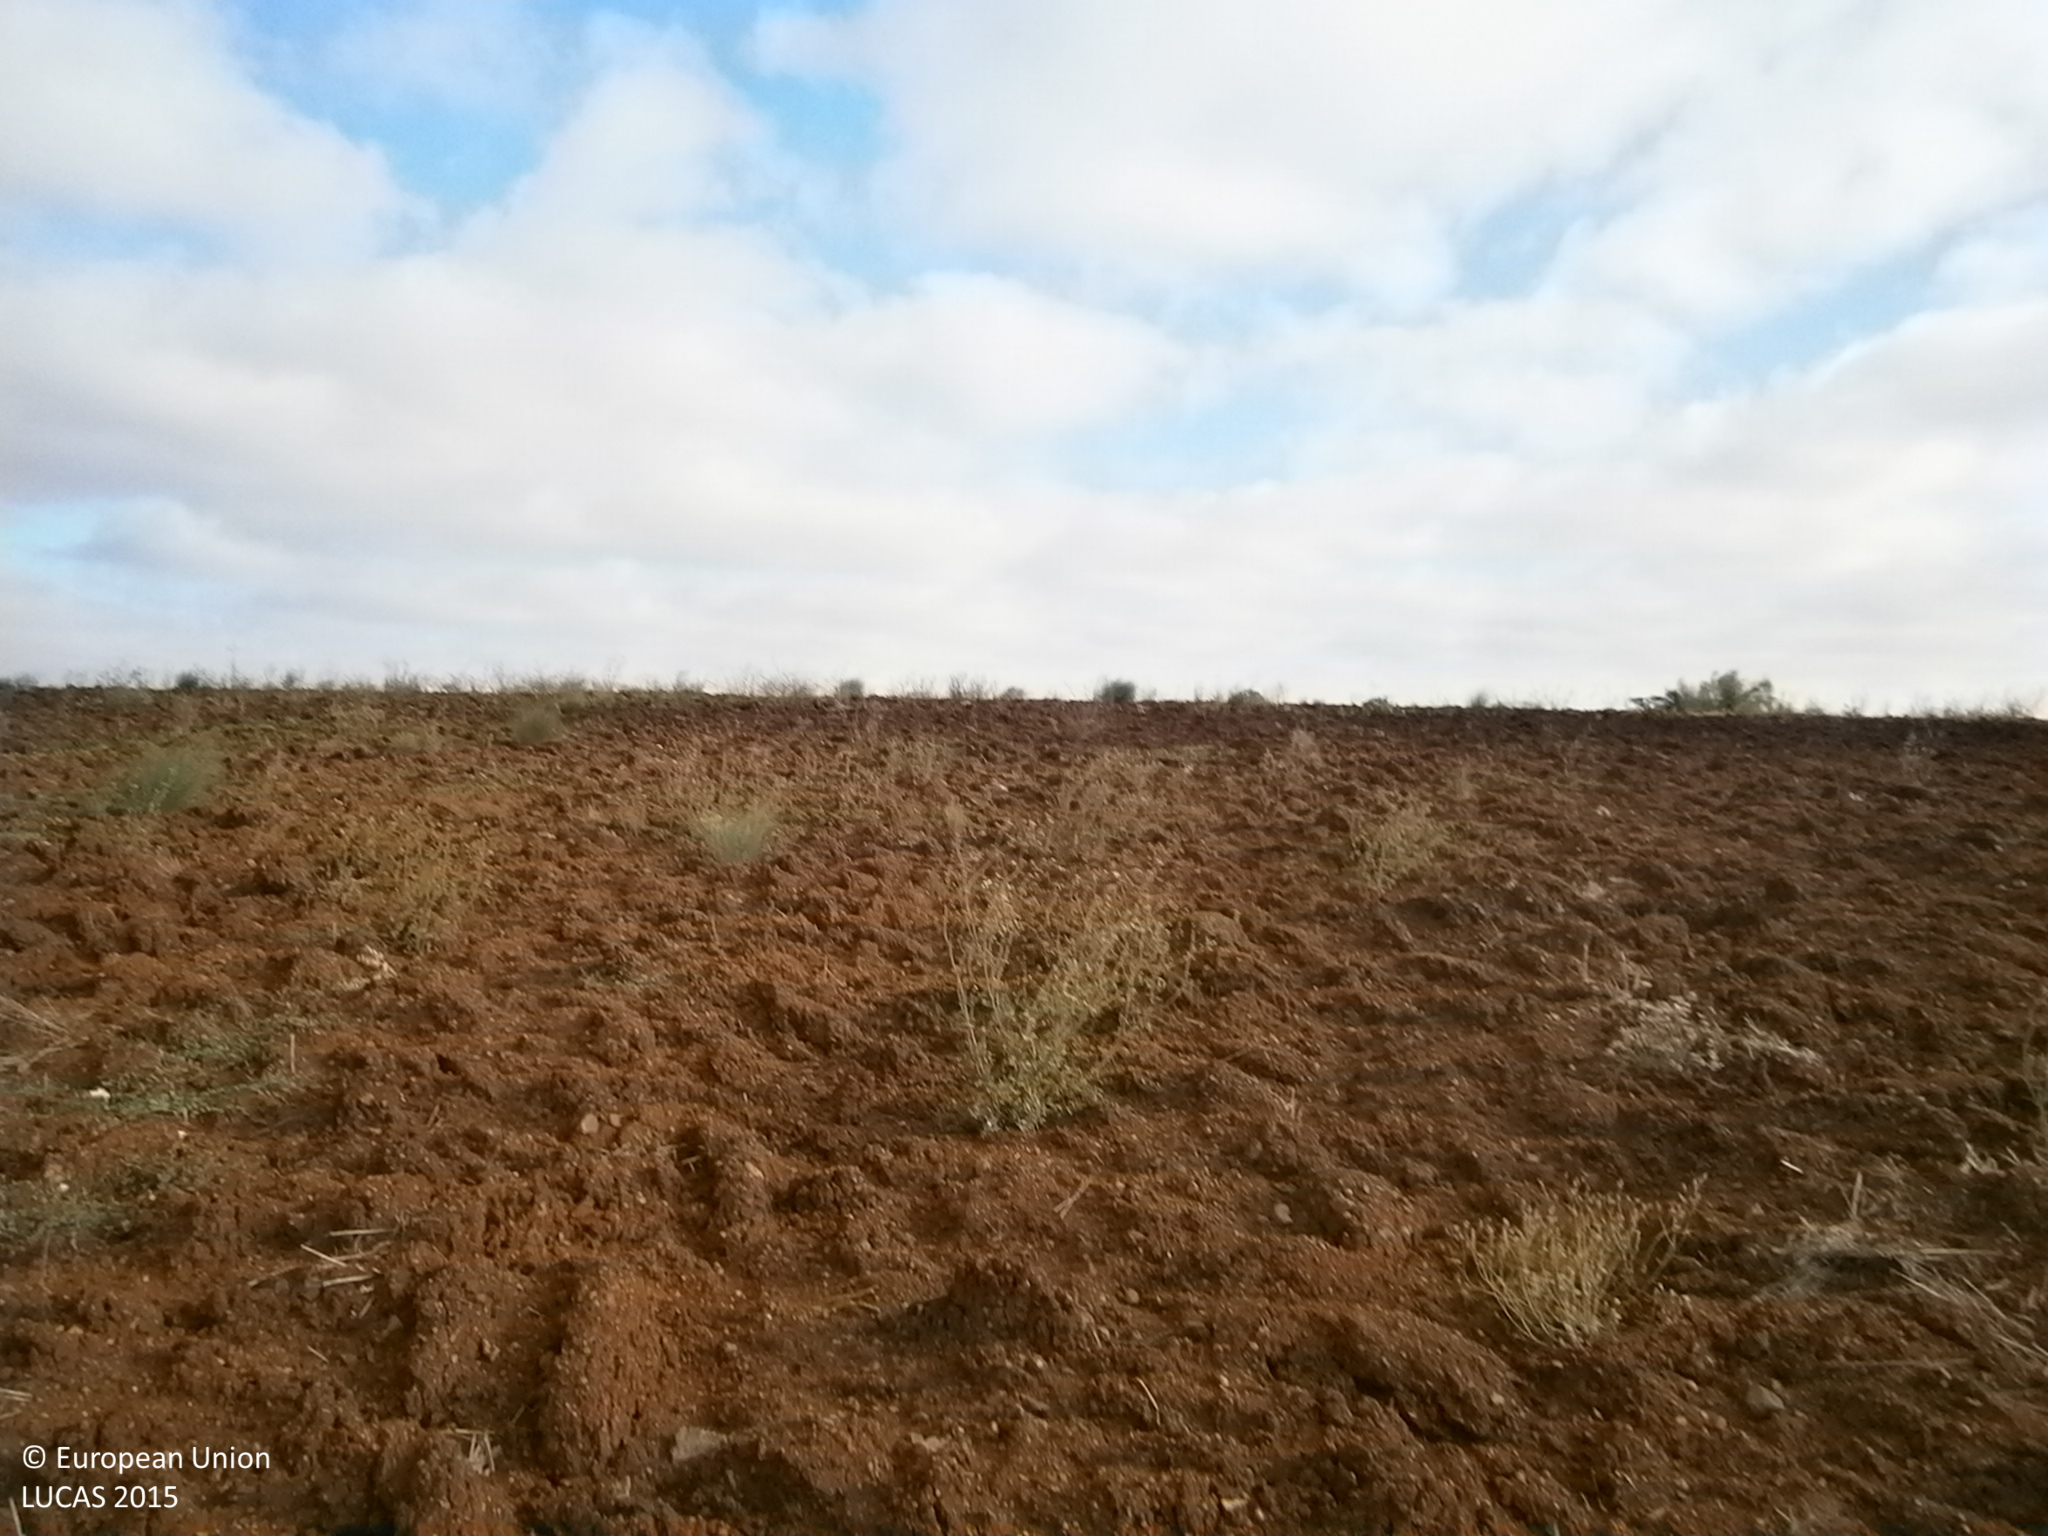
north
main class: Grassland
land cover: Spontaneously vegetated surfaces
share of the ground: > 75 %
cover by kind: herbaceous plants 75 %, unconsolidated bare surface 25 %
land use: Fallow land
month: June
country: ES
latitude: 38.6760
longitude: -6.8101
